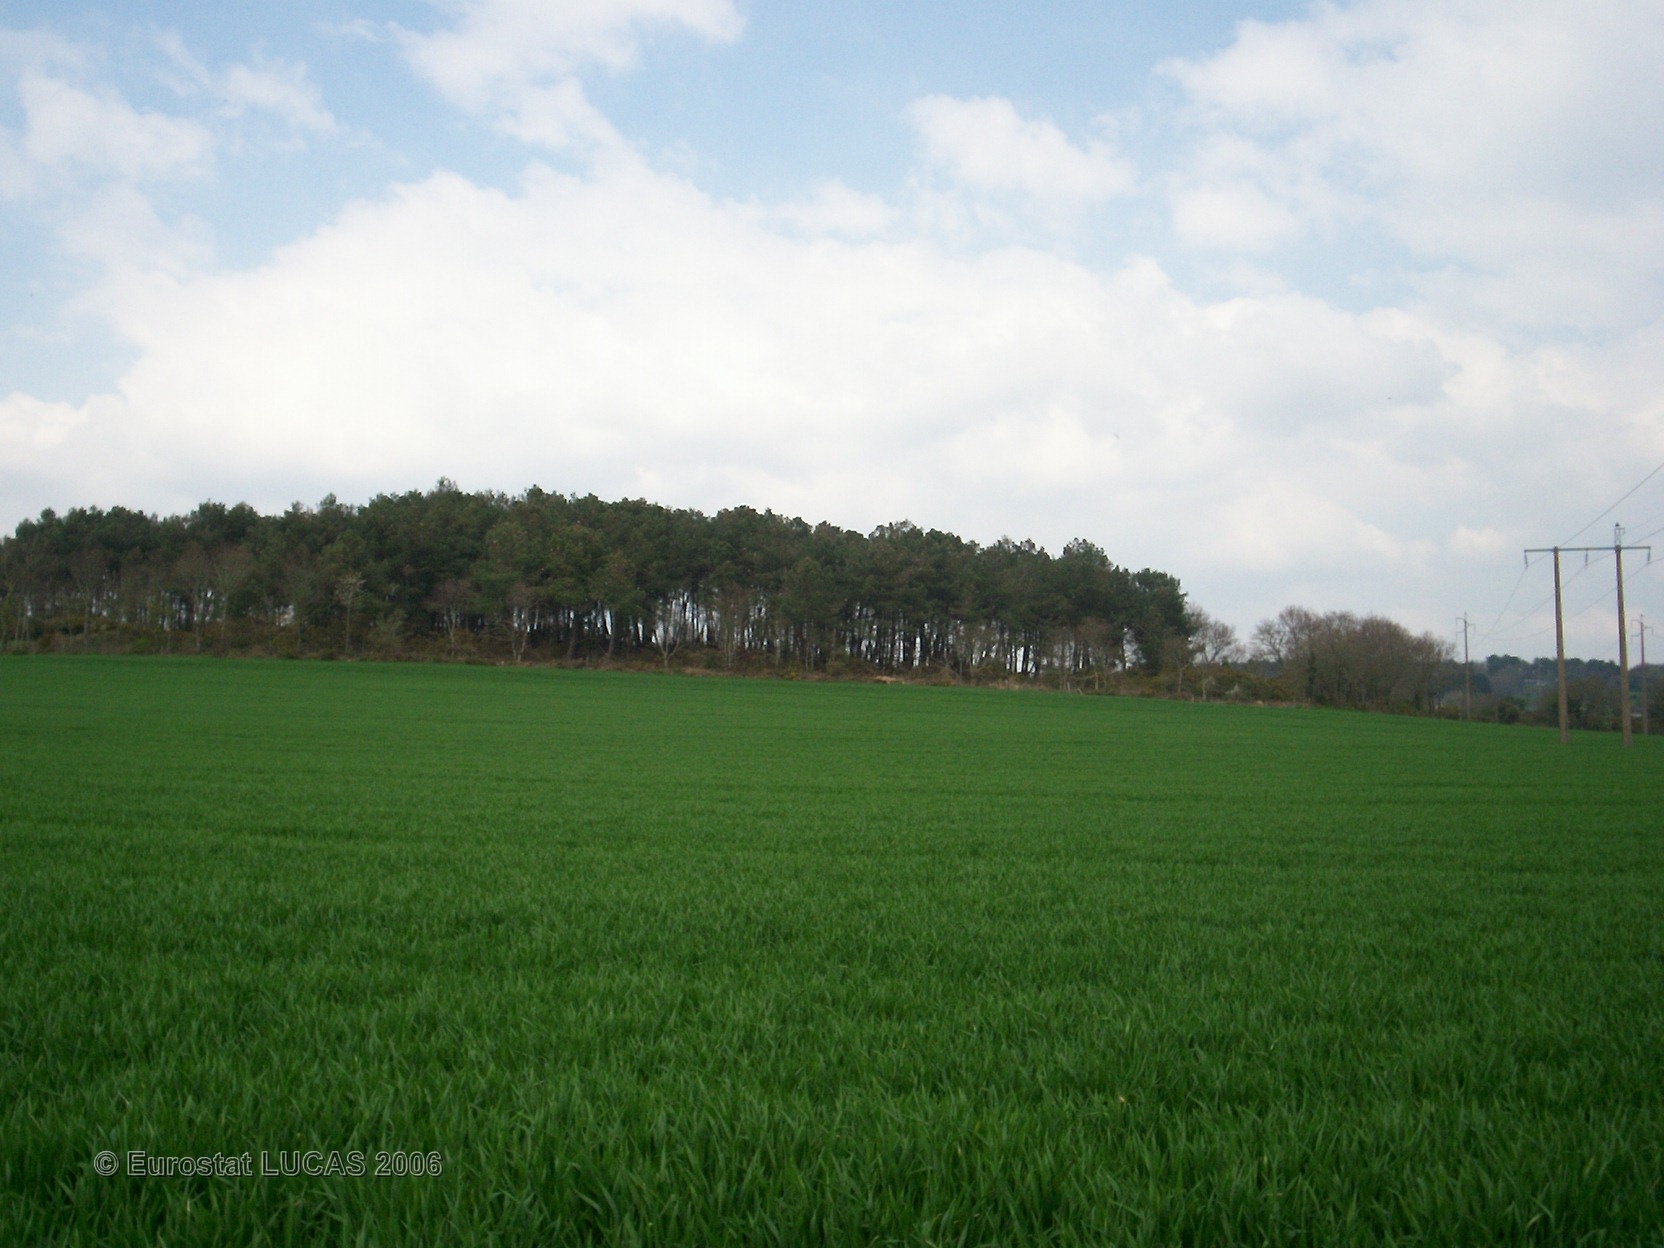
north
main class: Cropland
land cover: Triticale
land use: Agriculture (excluding fallow land and kitchen gardens)
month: April
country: FR
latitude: 47.6708
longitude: -2.6731
